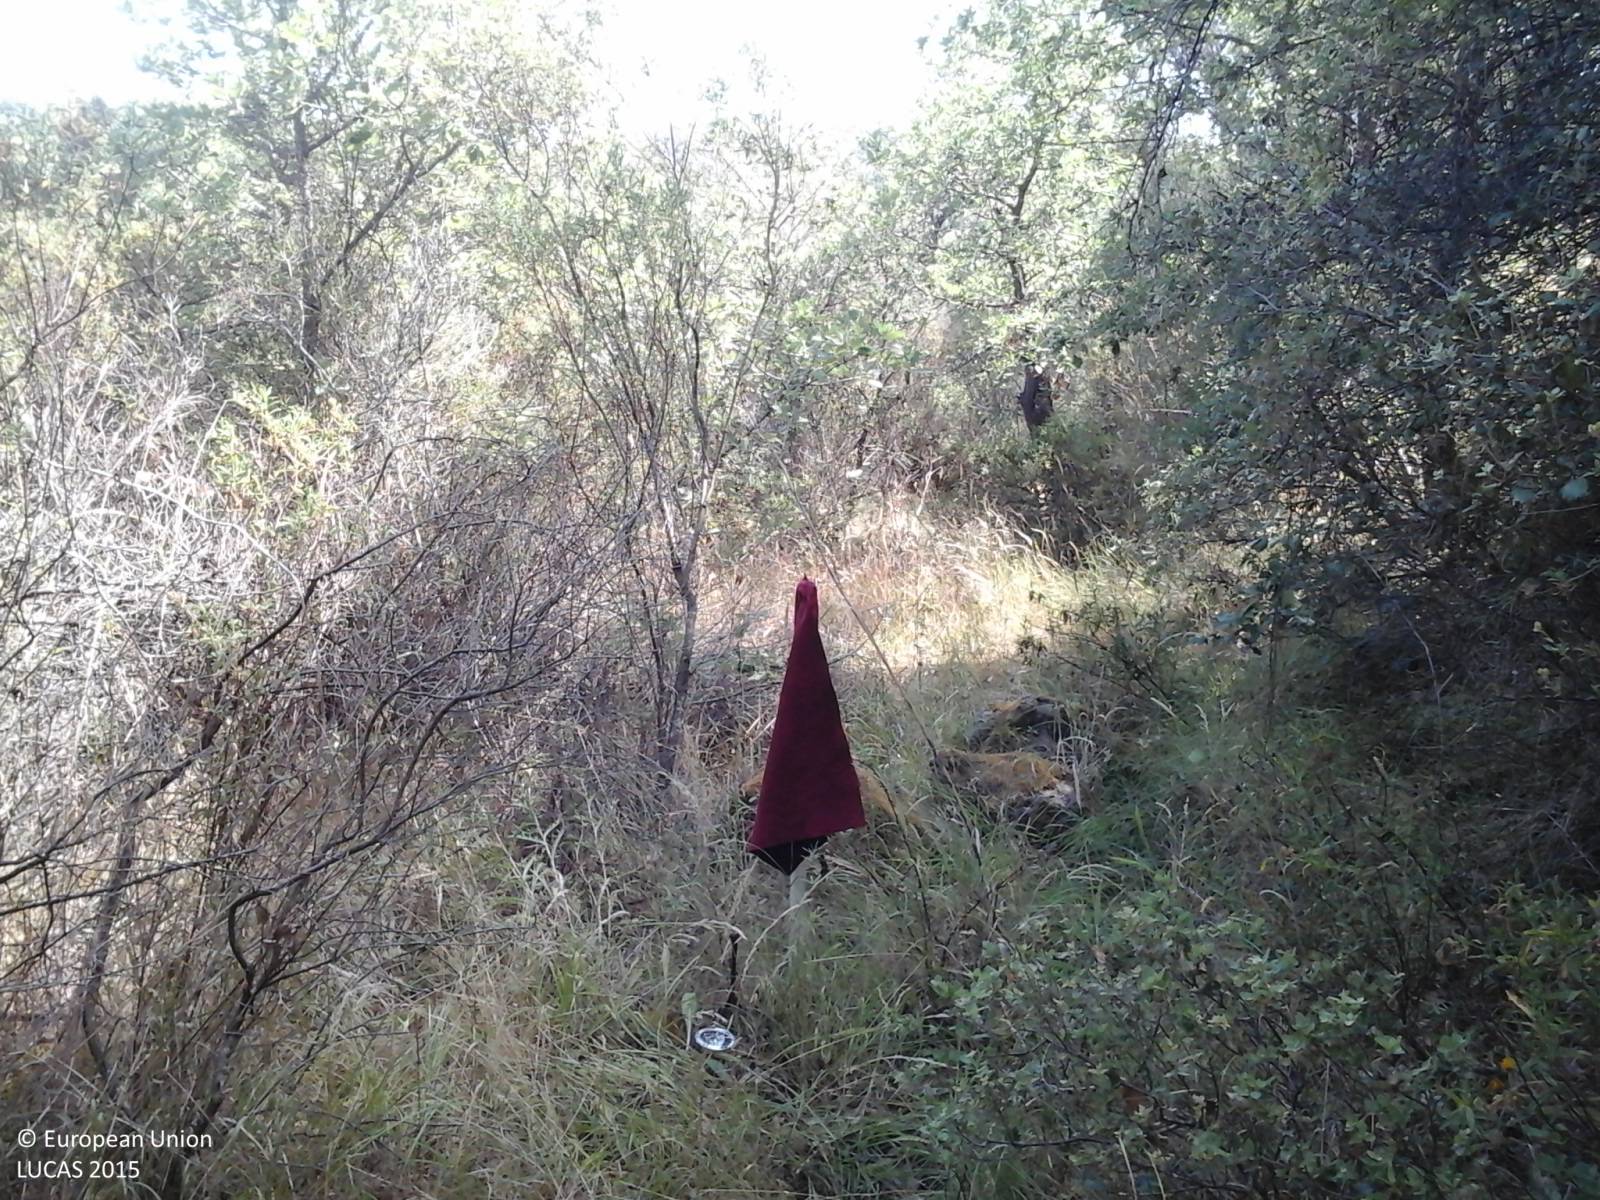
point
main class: Woodland
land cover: Broadleaved woodland
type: broadleaved evergreen forest
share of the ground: < 10 %
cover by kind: herbaceous plants 65 %, shrubs 20 %, broadleaved forest trees 10 %
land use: Semi-natural and natural areas not in use
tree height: < 5 m
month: June
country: IT
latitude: 40.5822
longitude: 8.5305
